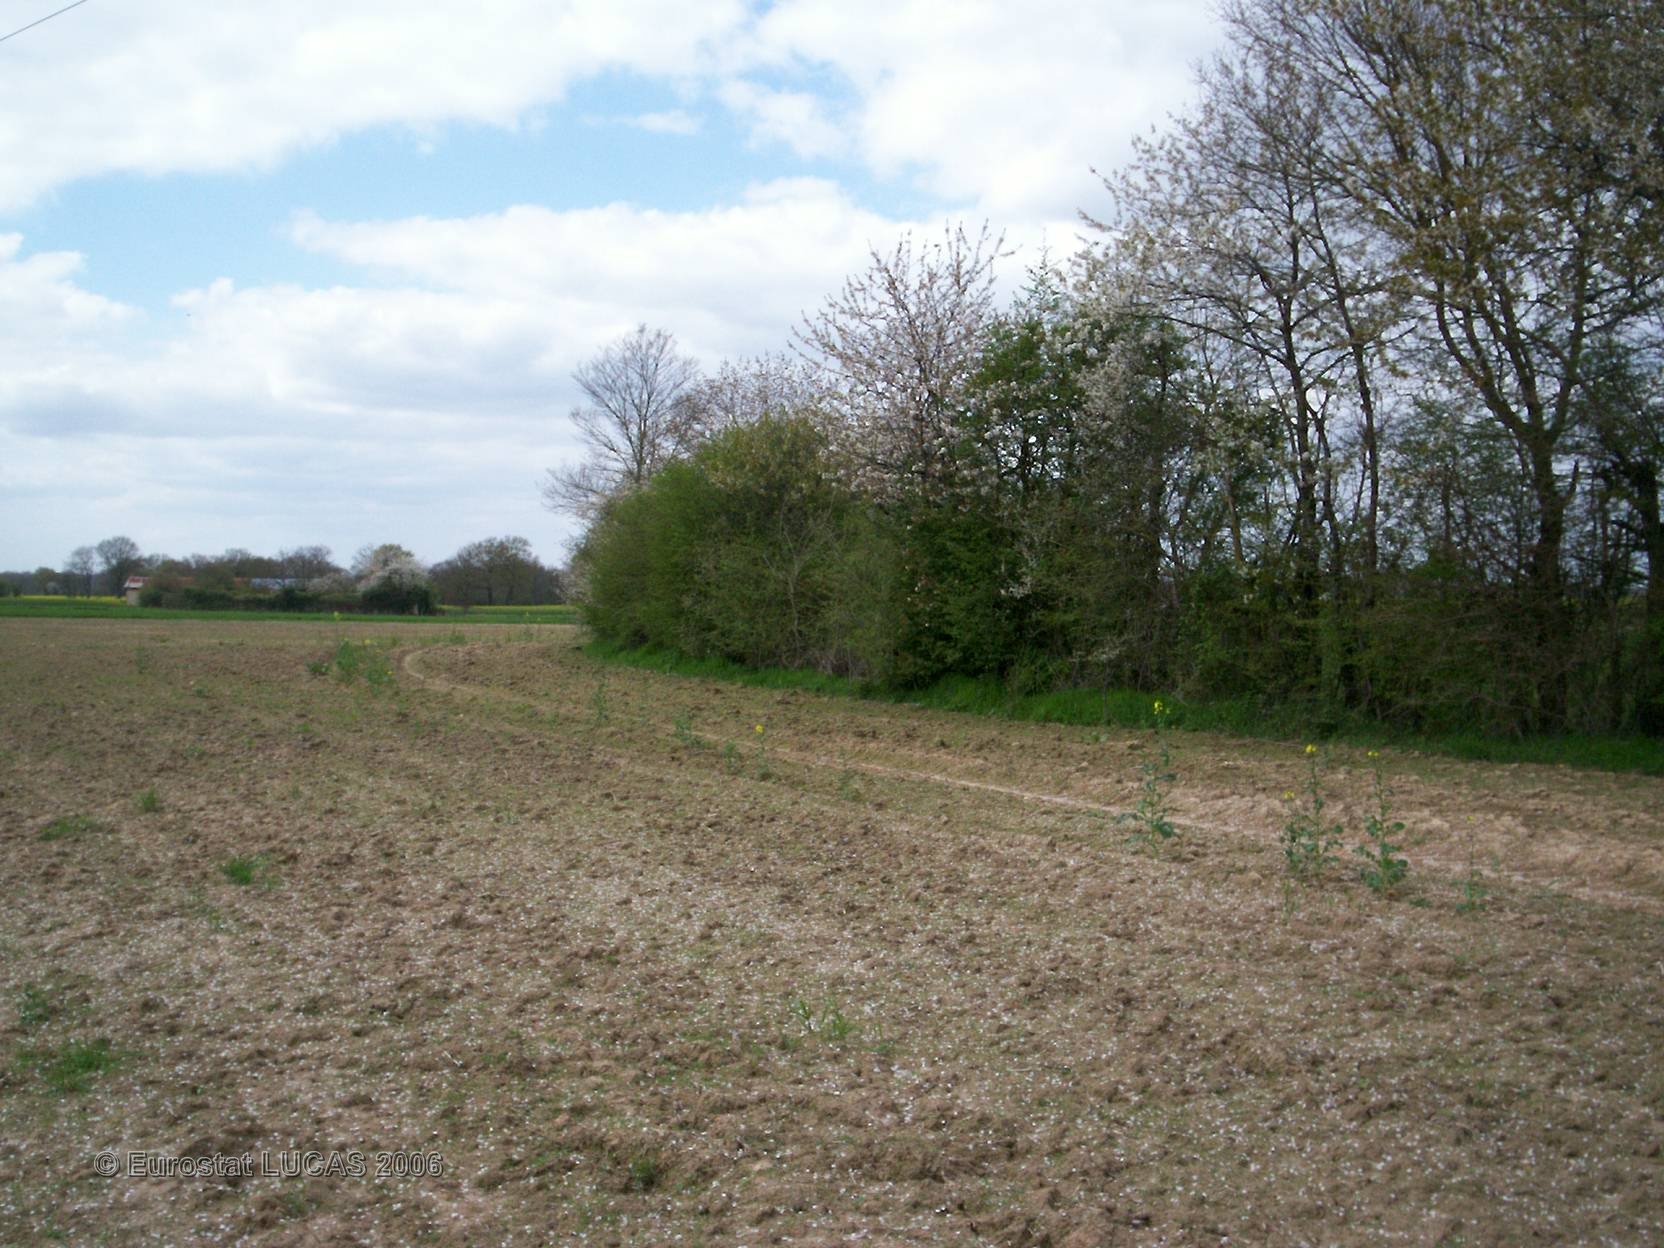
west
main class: Grassland
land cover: Grassland without tree/shrub cover
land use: Agriculture (excluding fallow land and kitchen gardens)
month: April
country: FR
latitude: 46.1849
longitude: 0.5396
